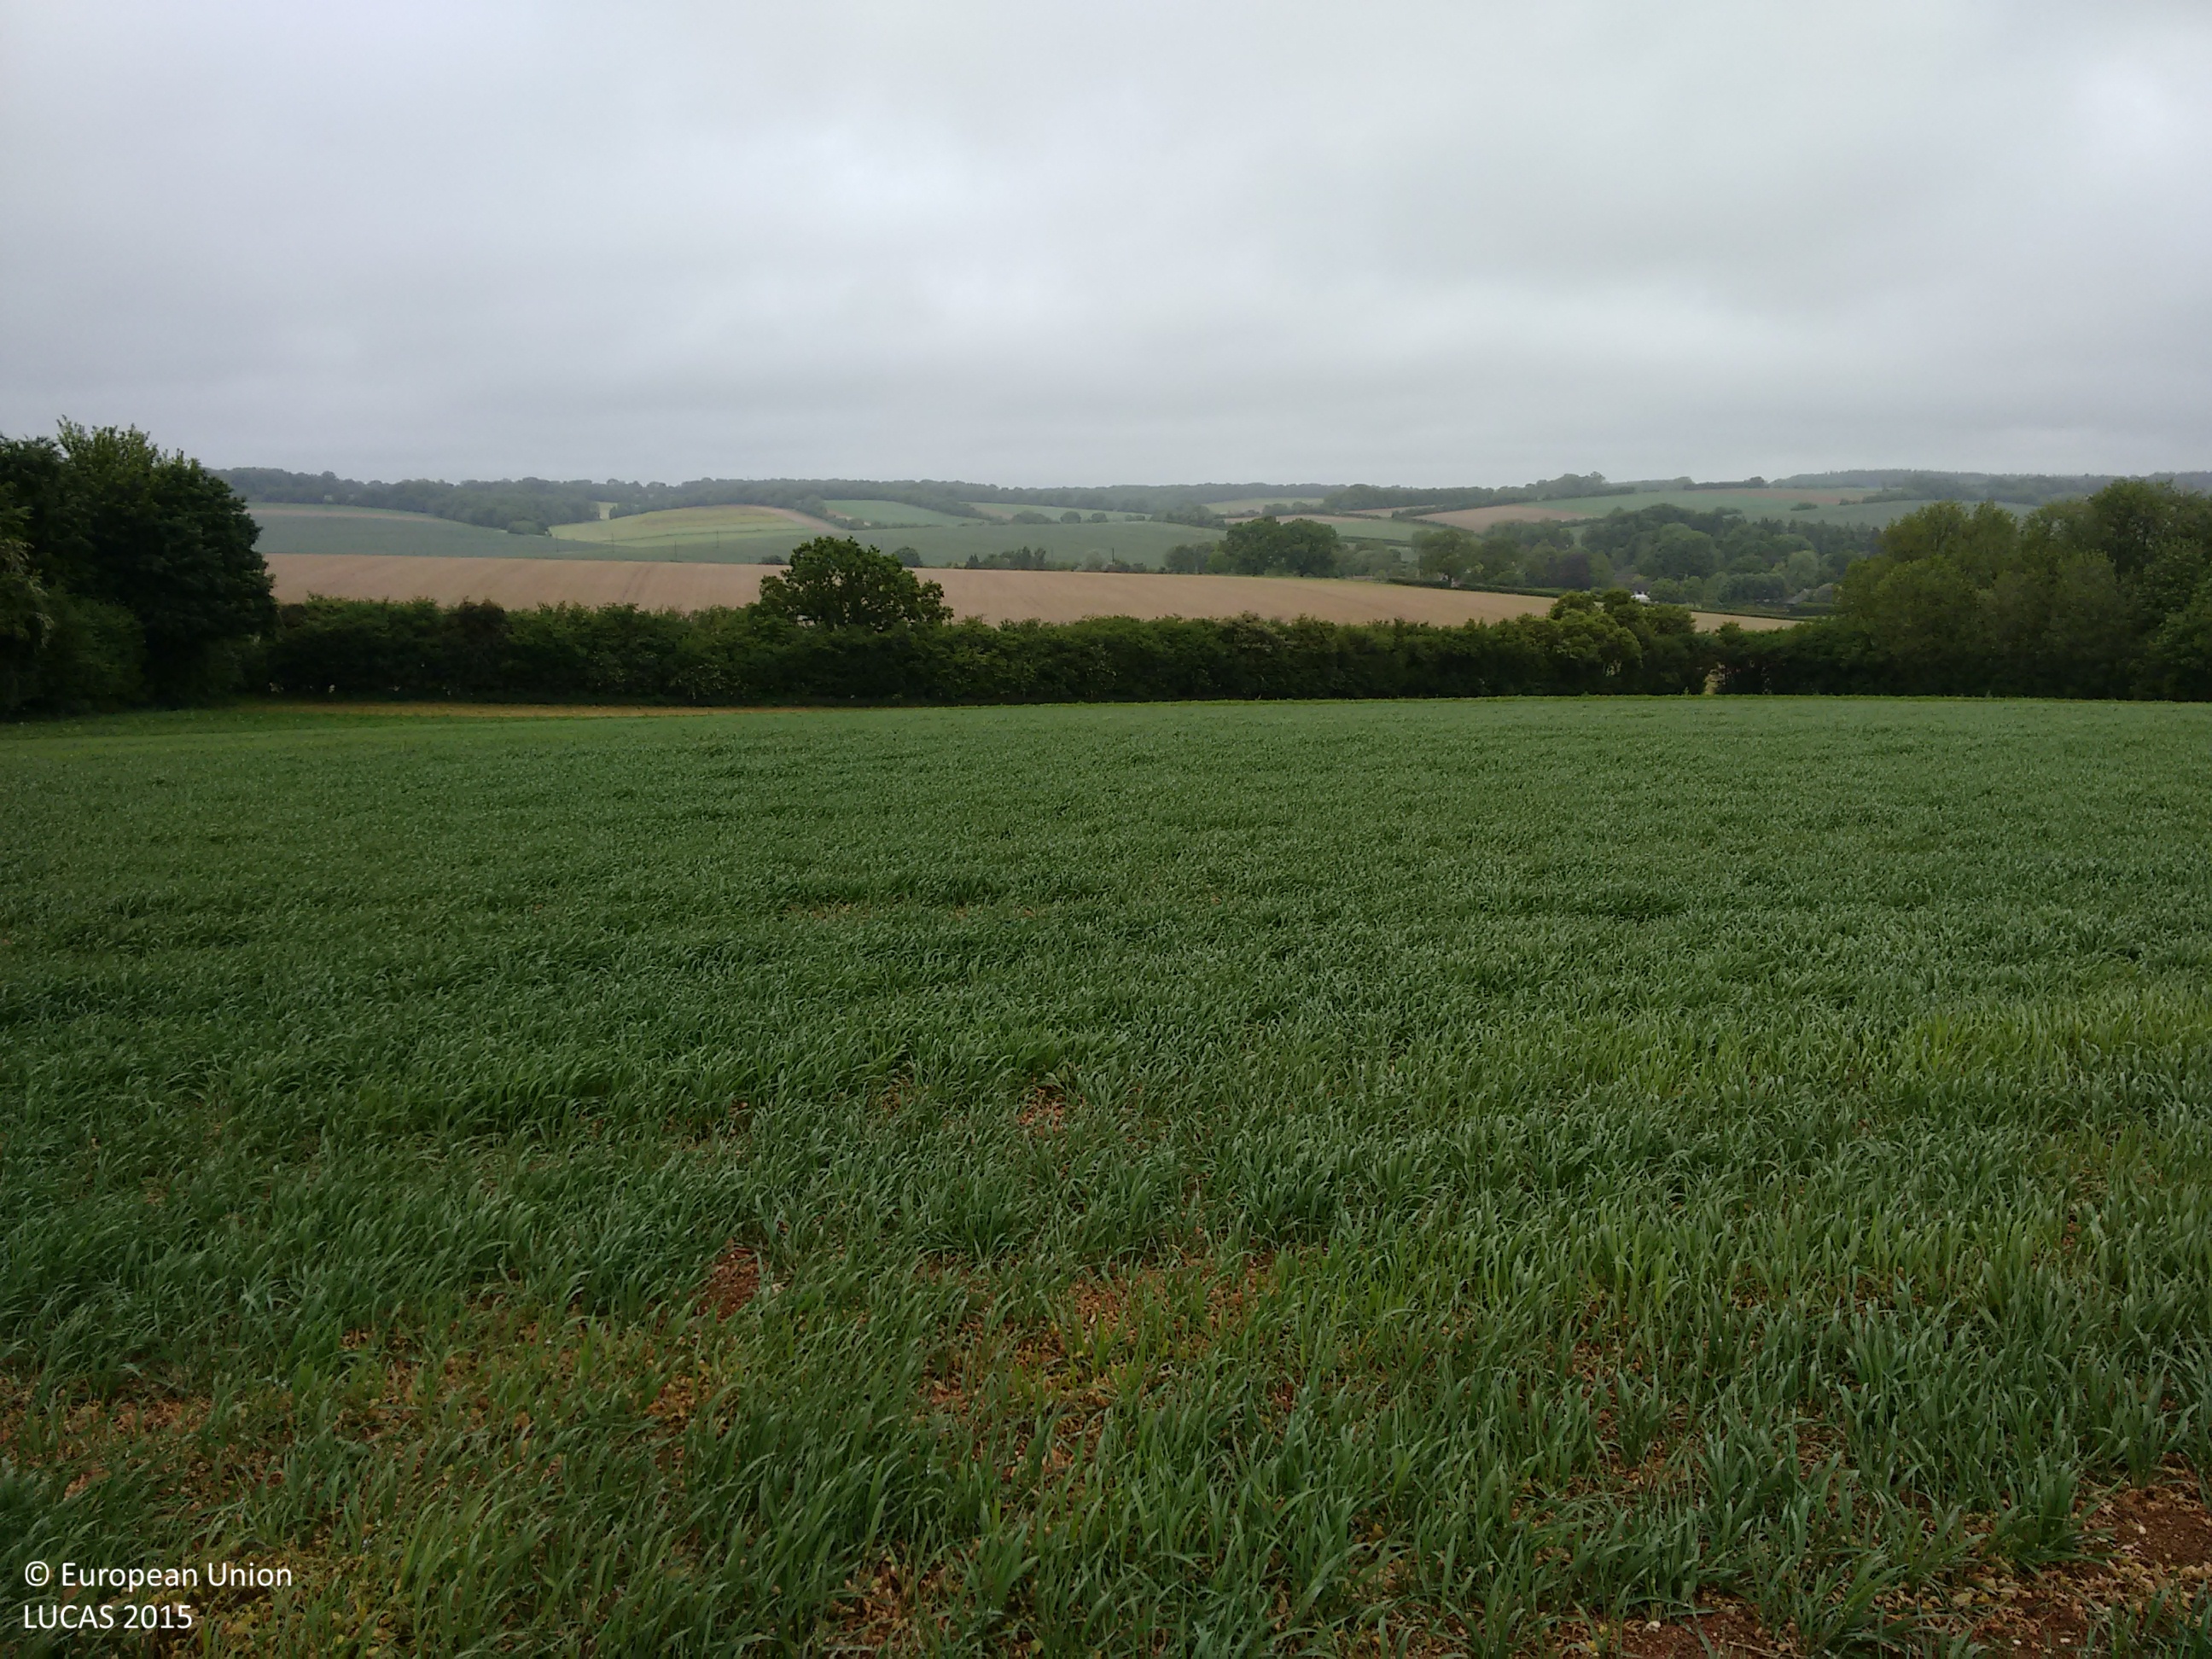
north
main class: Cropland
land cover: Barley
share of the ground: 50 - 75 %
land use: Agriculture (excluding fallow land and kitchen gardens)
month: June
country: GB
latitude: 51.1803
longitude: -1.1328
